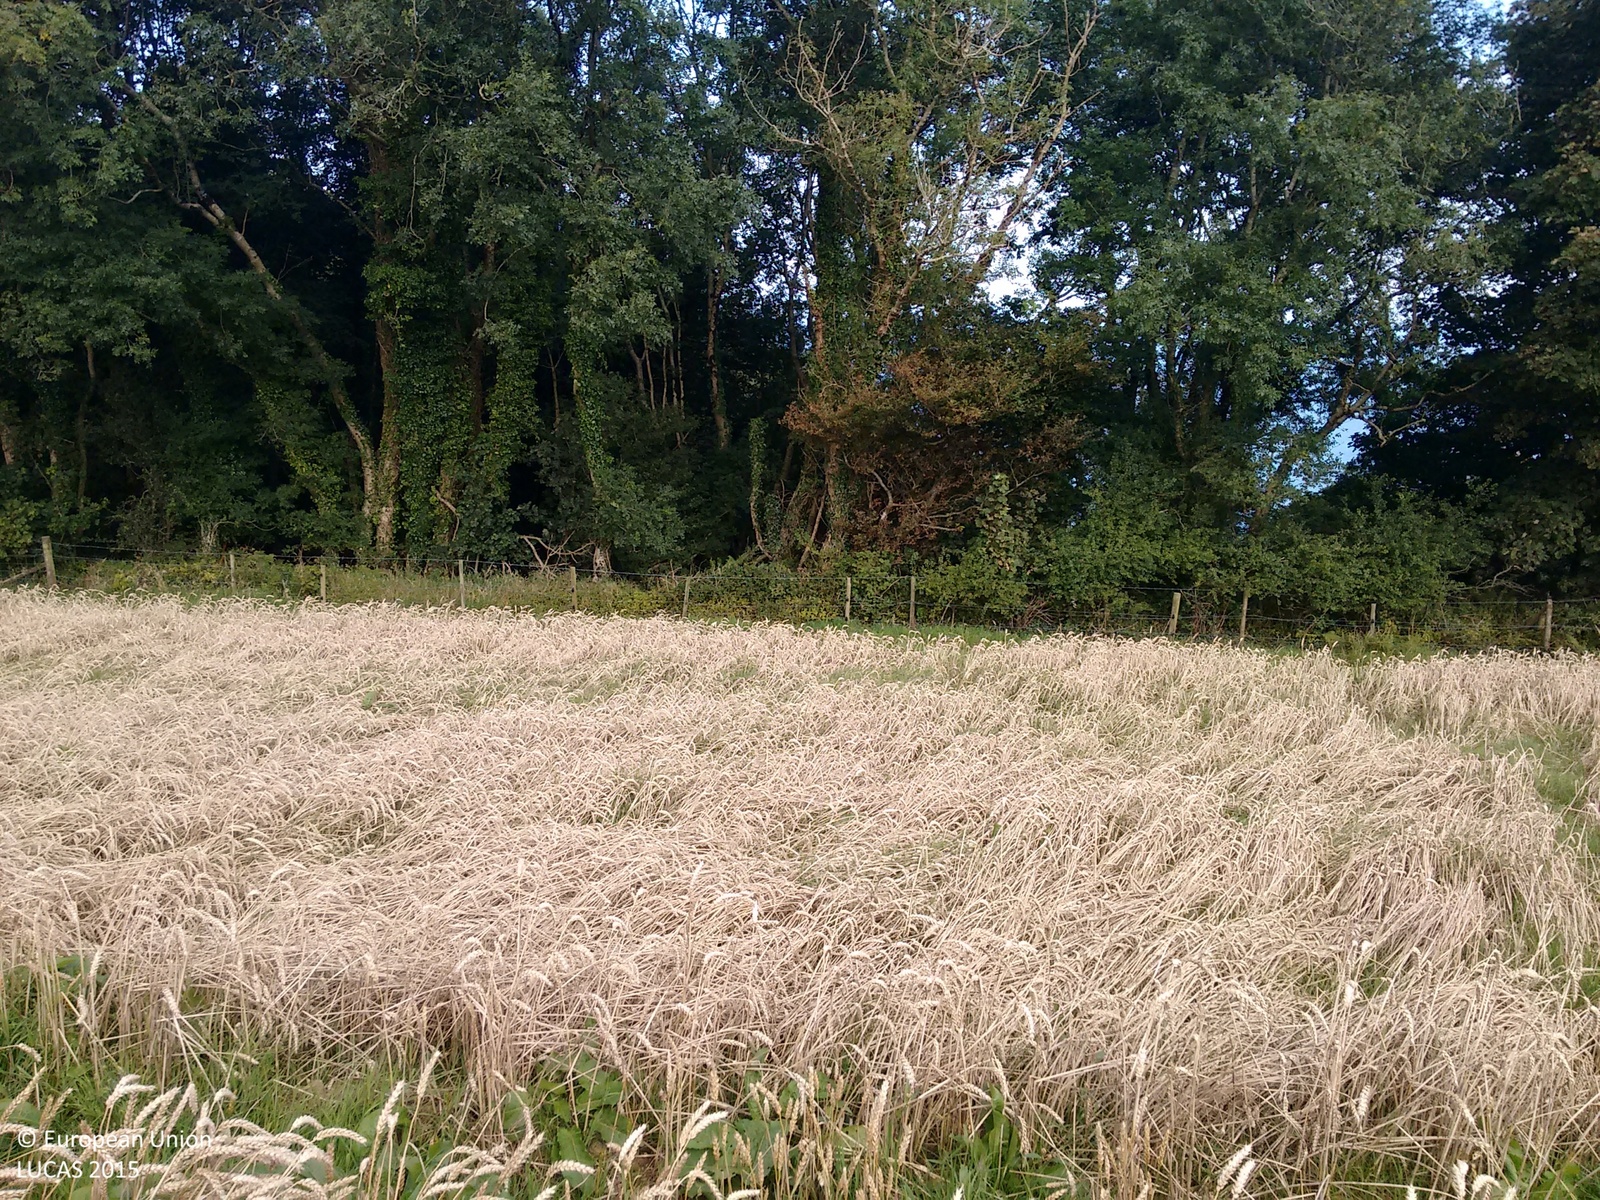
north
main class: Cropland
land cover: Common wheat
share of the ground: > 75 %
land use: Agriculture (excluding fallow land and kitchen gardens)
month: September
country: GB
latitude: 50.9863
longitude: -4.3617
